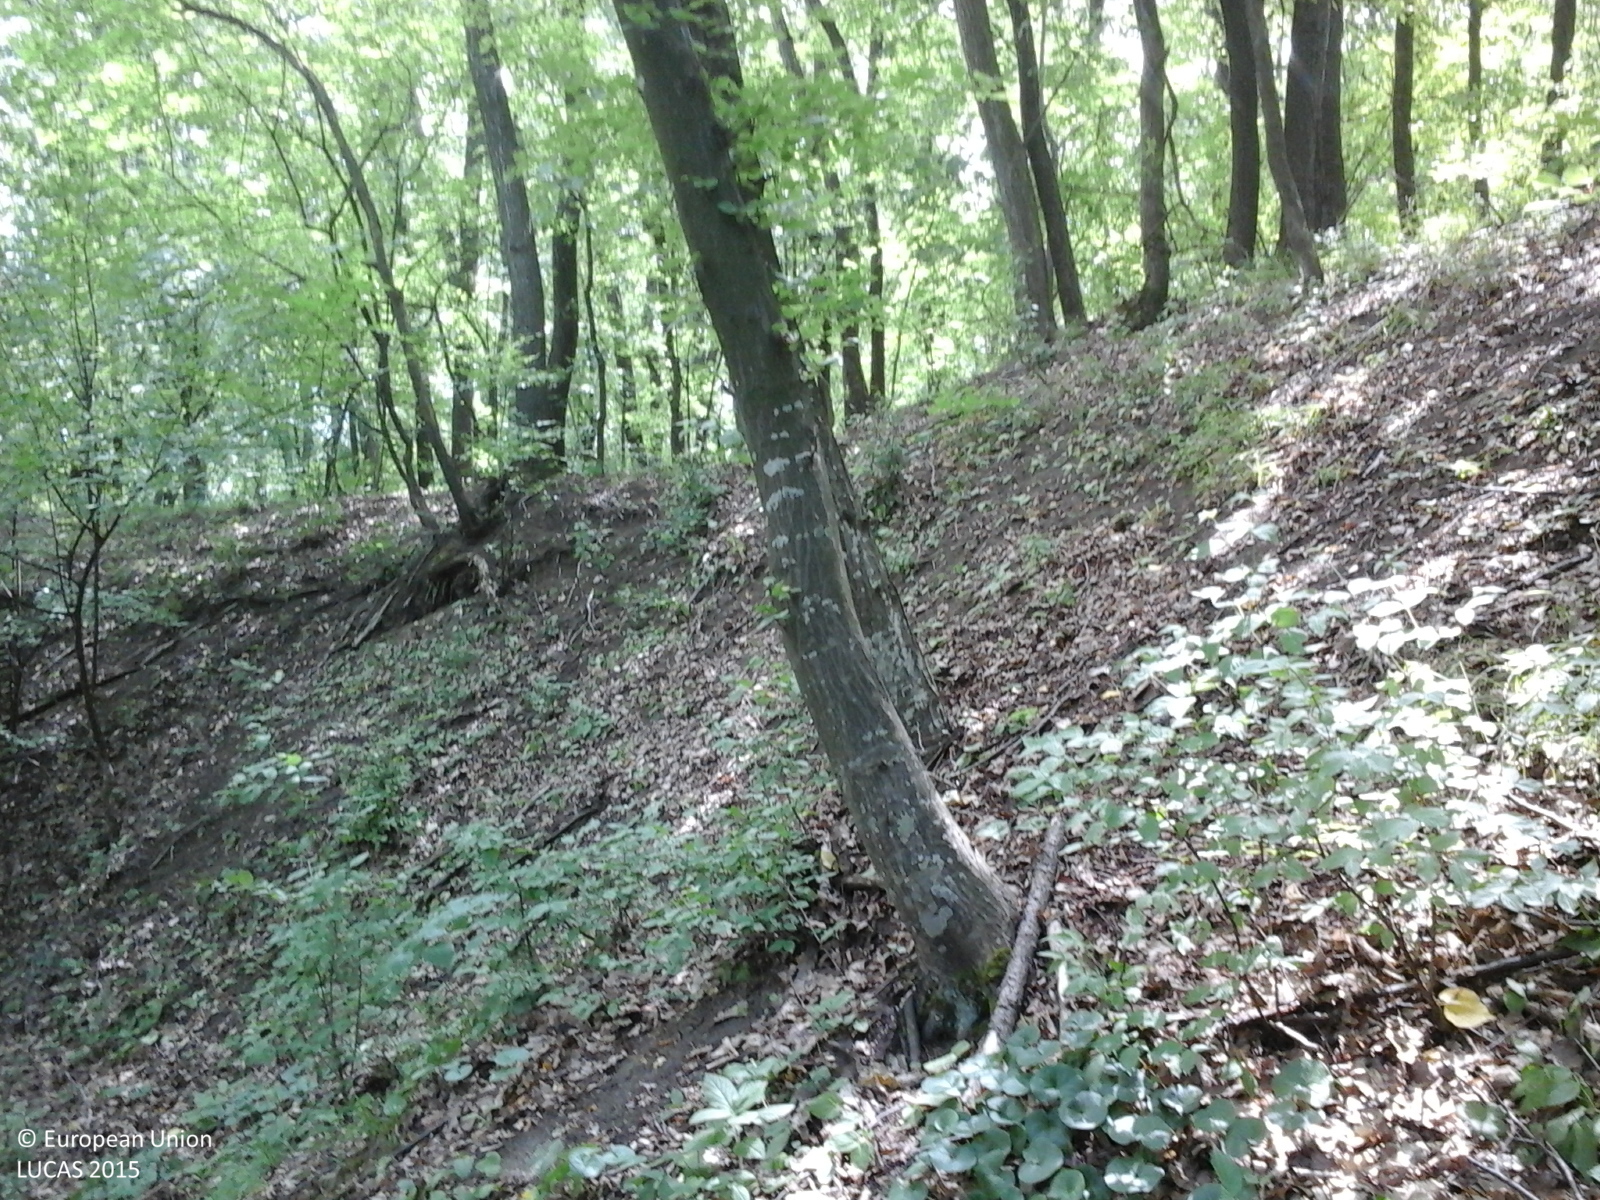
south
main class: Woodland
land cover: Broadleaved woodland
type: beech forest
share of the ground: > 75 %
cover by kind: broadleaved forest trees 95 %, herbaceous plants 5 %
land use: Forestry
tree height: > 5 m
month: June
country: RO
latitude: 47.8932
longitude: 26.3377
